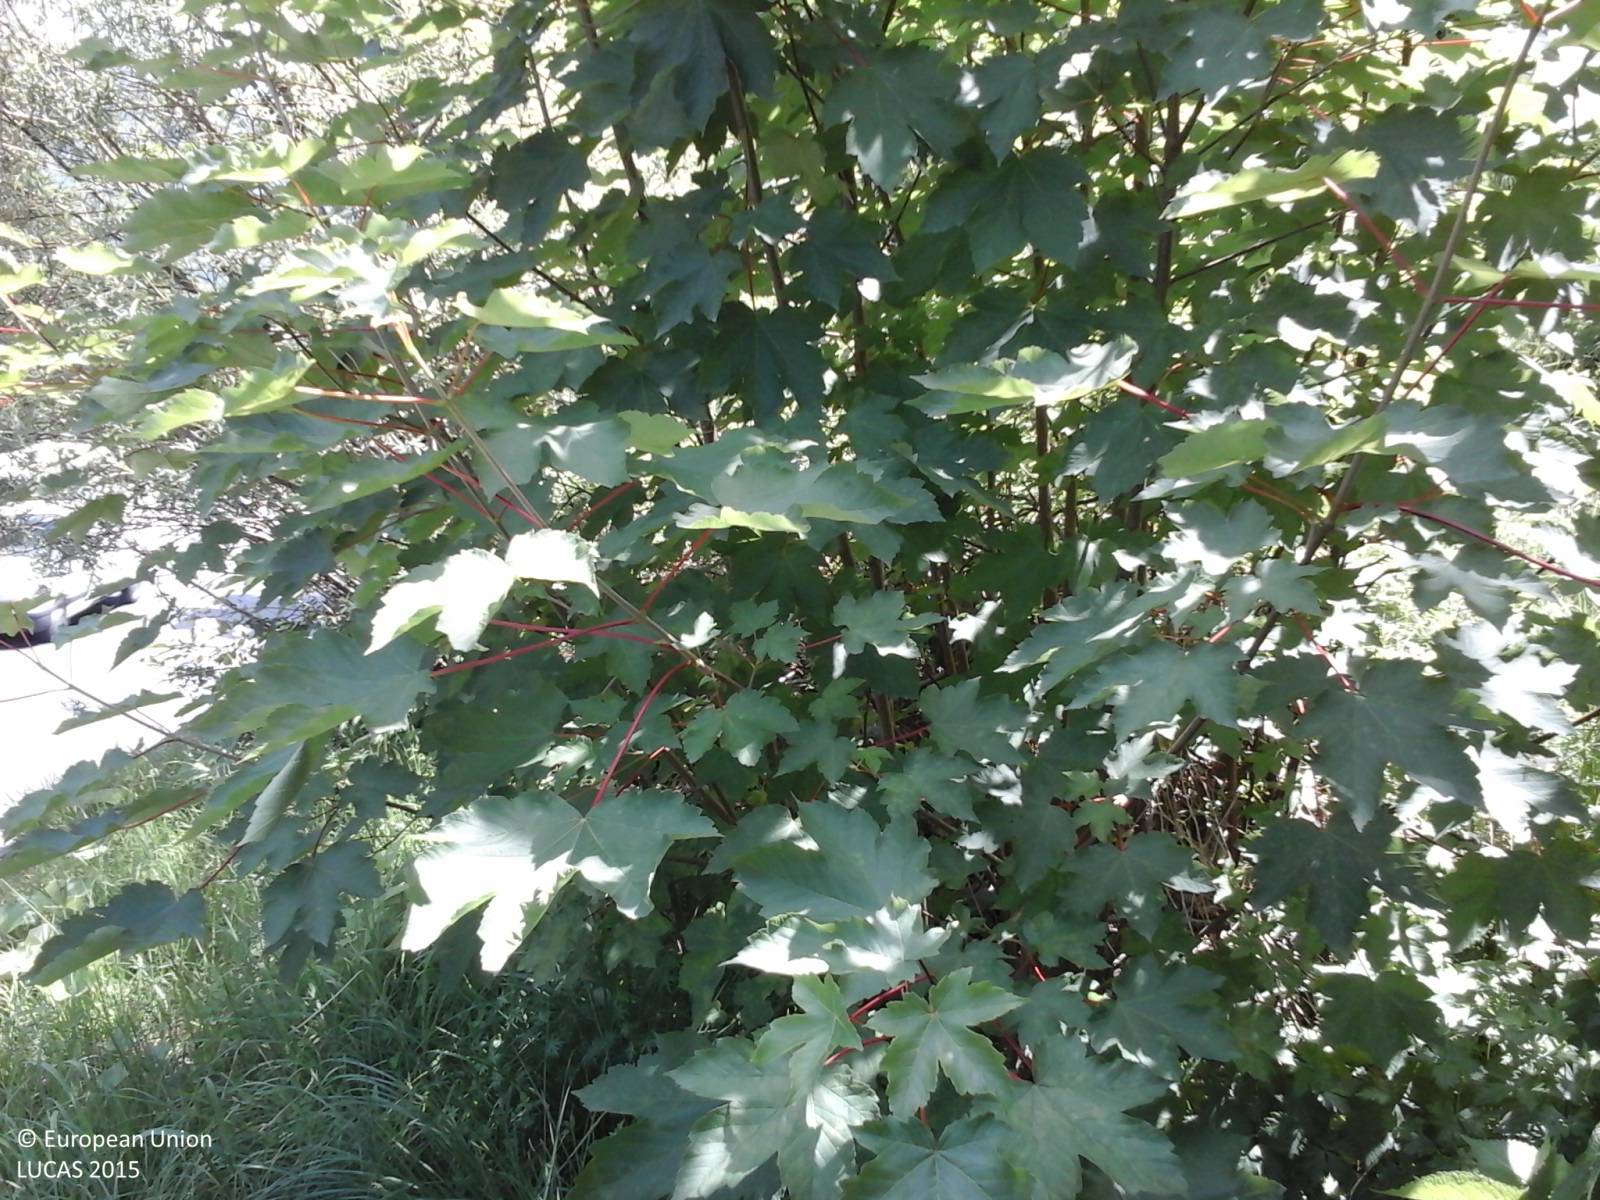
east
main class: Woodland
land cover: Pine dominated coniferous woodland
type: alpine coniferous forest
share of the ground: > 75 %
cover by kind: coniferous forest trees 70 %, broadleaved forest trees 10 %, shrubs 10 %, herbaceous plants 10 %
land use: Semi-natural and natural areas not in use
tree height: > 5 m
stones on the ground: 25 - 50 %
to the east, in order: Pine dominated coniferous woodland
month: June
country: IT
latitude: 46.3924
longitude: 13.2350
